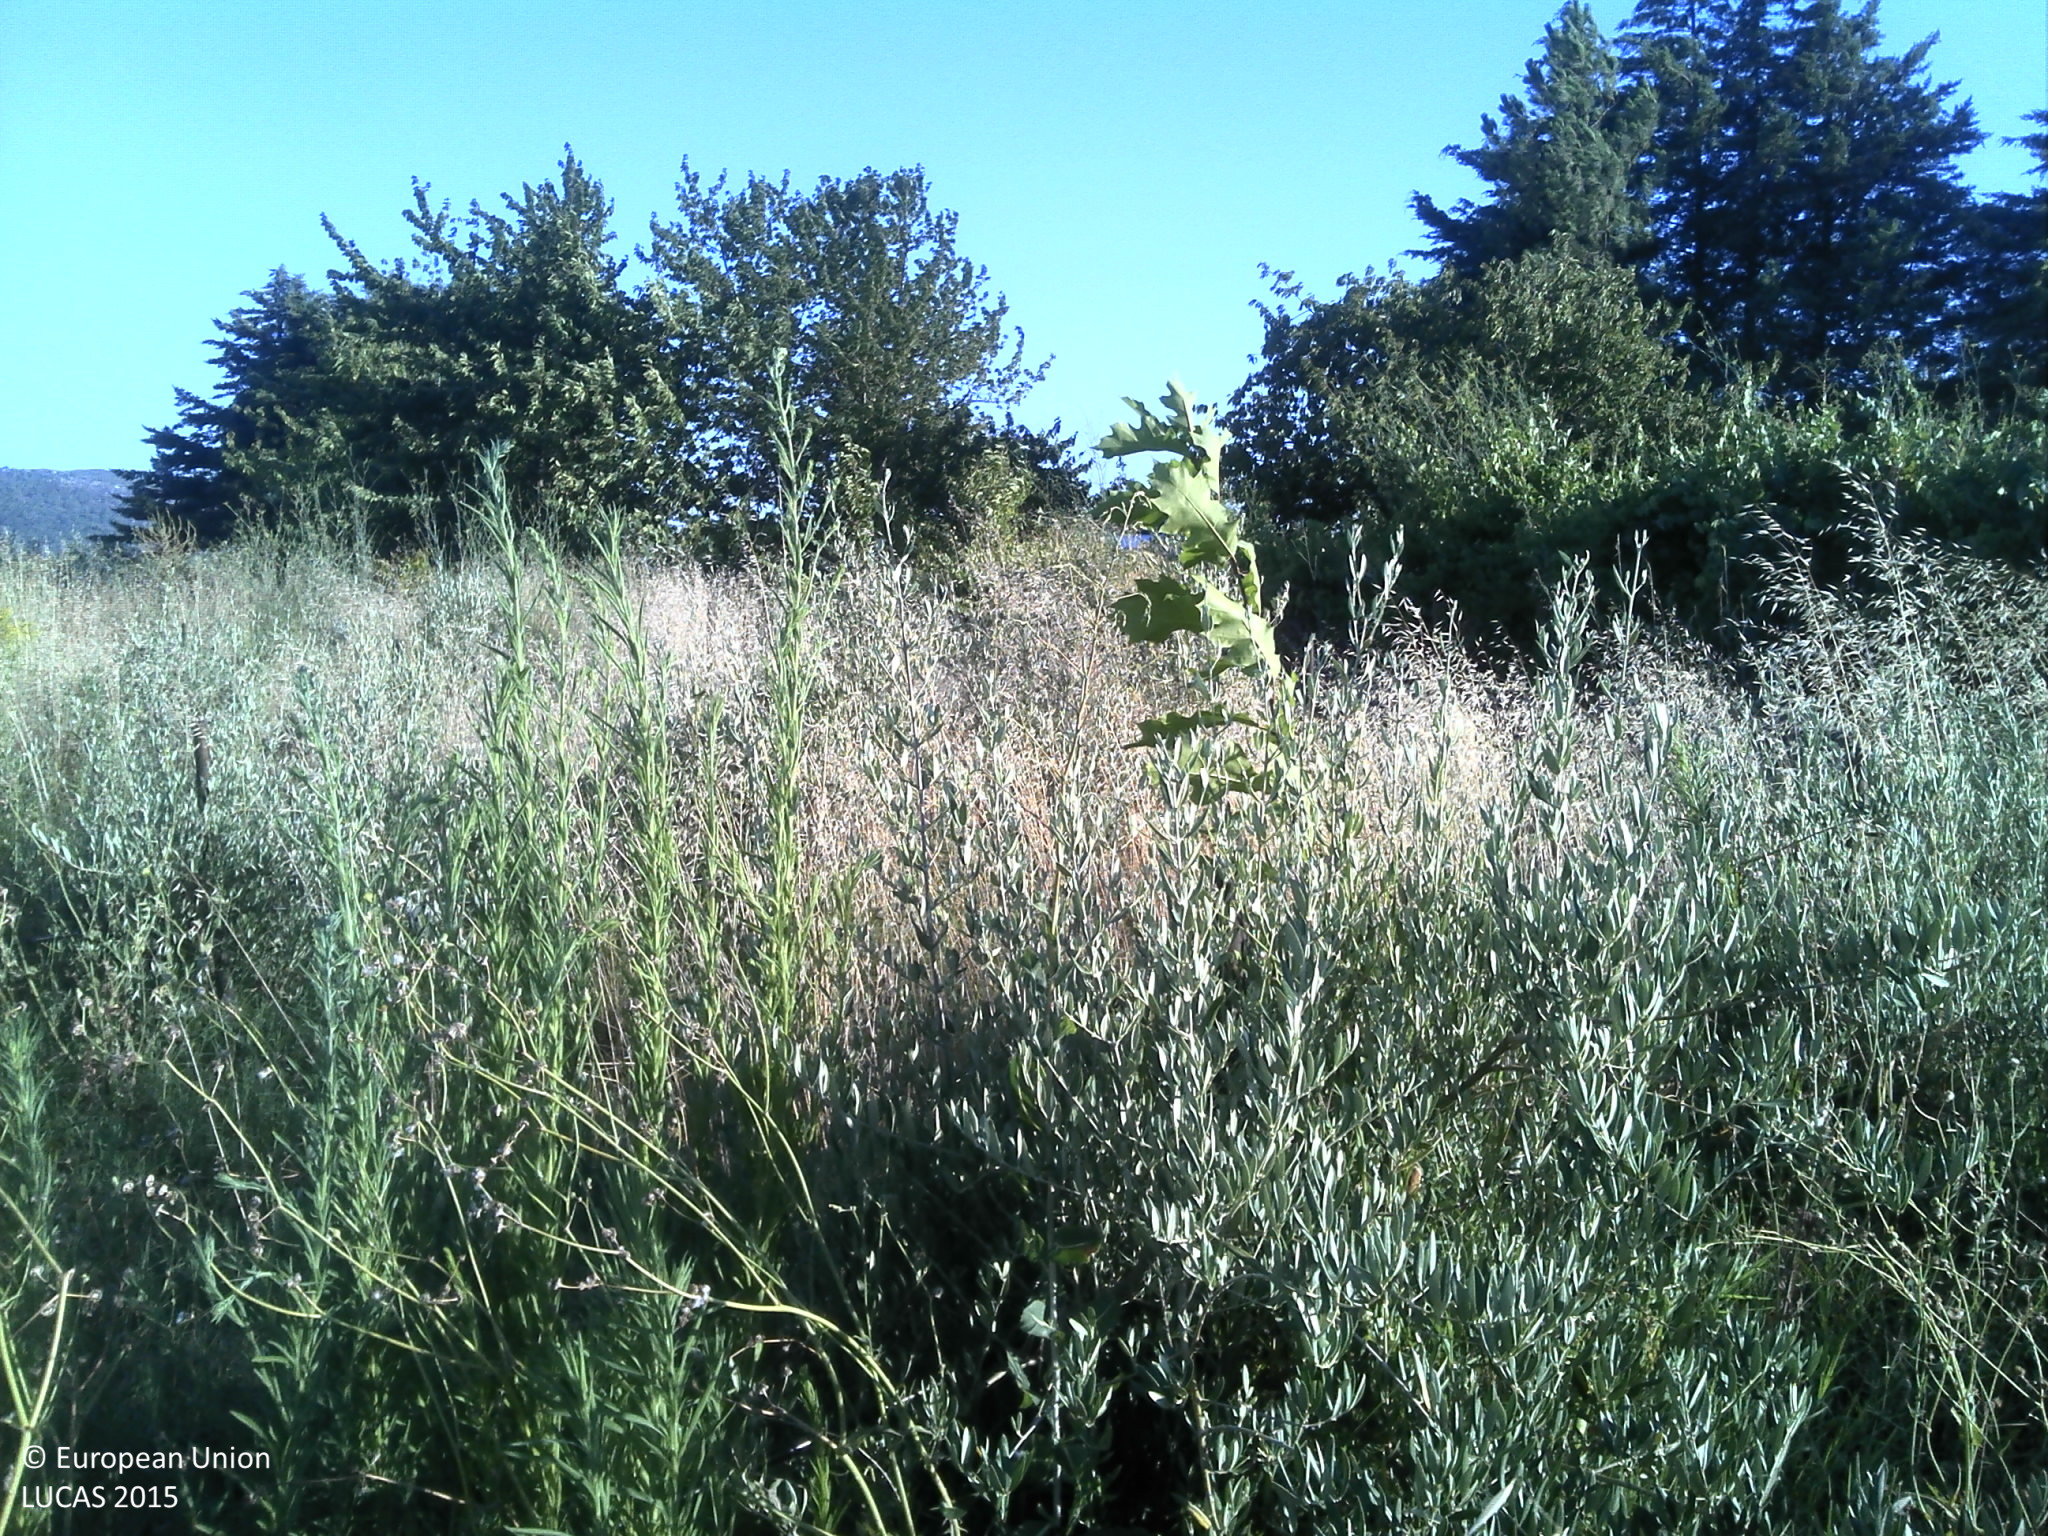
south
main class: Cropland
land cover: Olive groves
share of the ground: 25 - 50 %
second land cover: Grassland without tree/shrub cover
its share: 25 - 50 %
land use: Agriculture (excluding fallow land and kitchen gardens)
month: July
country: PT
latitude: 40.3632
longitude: -7.3809
